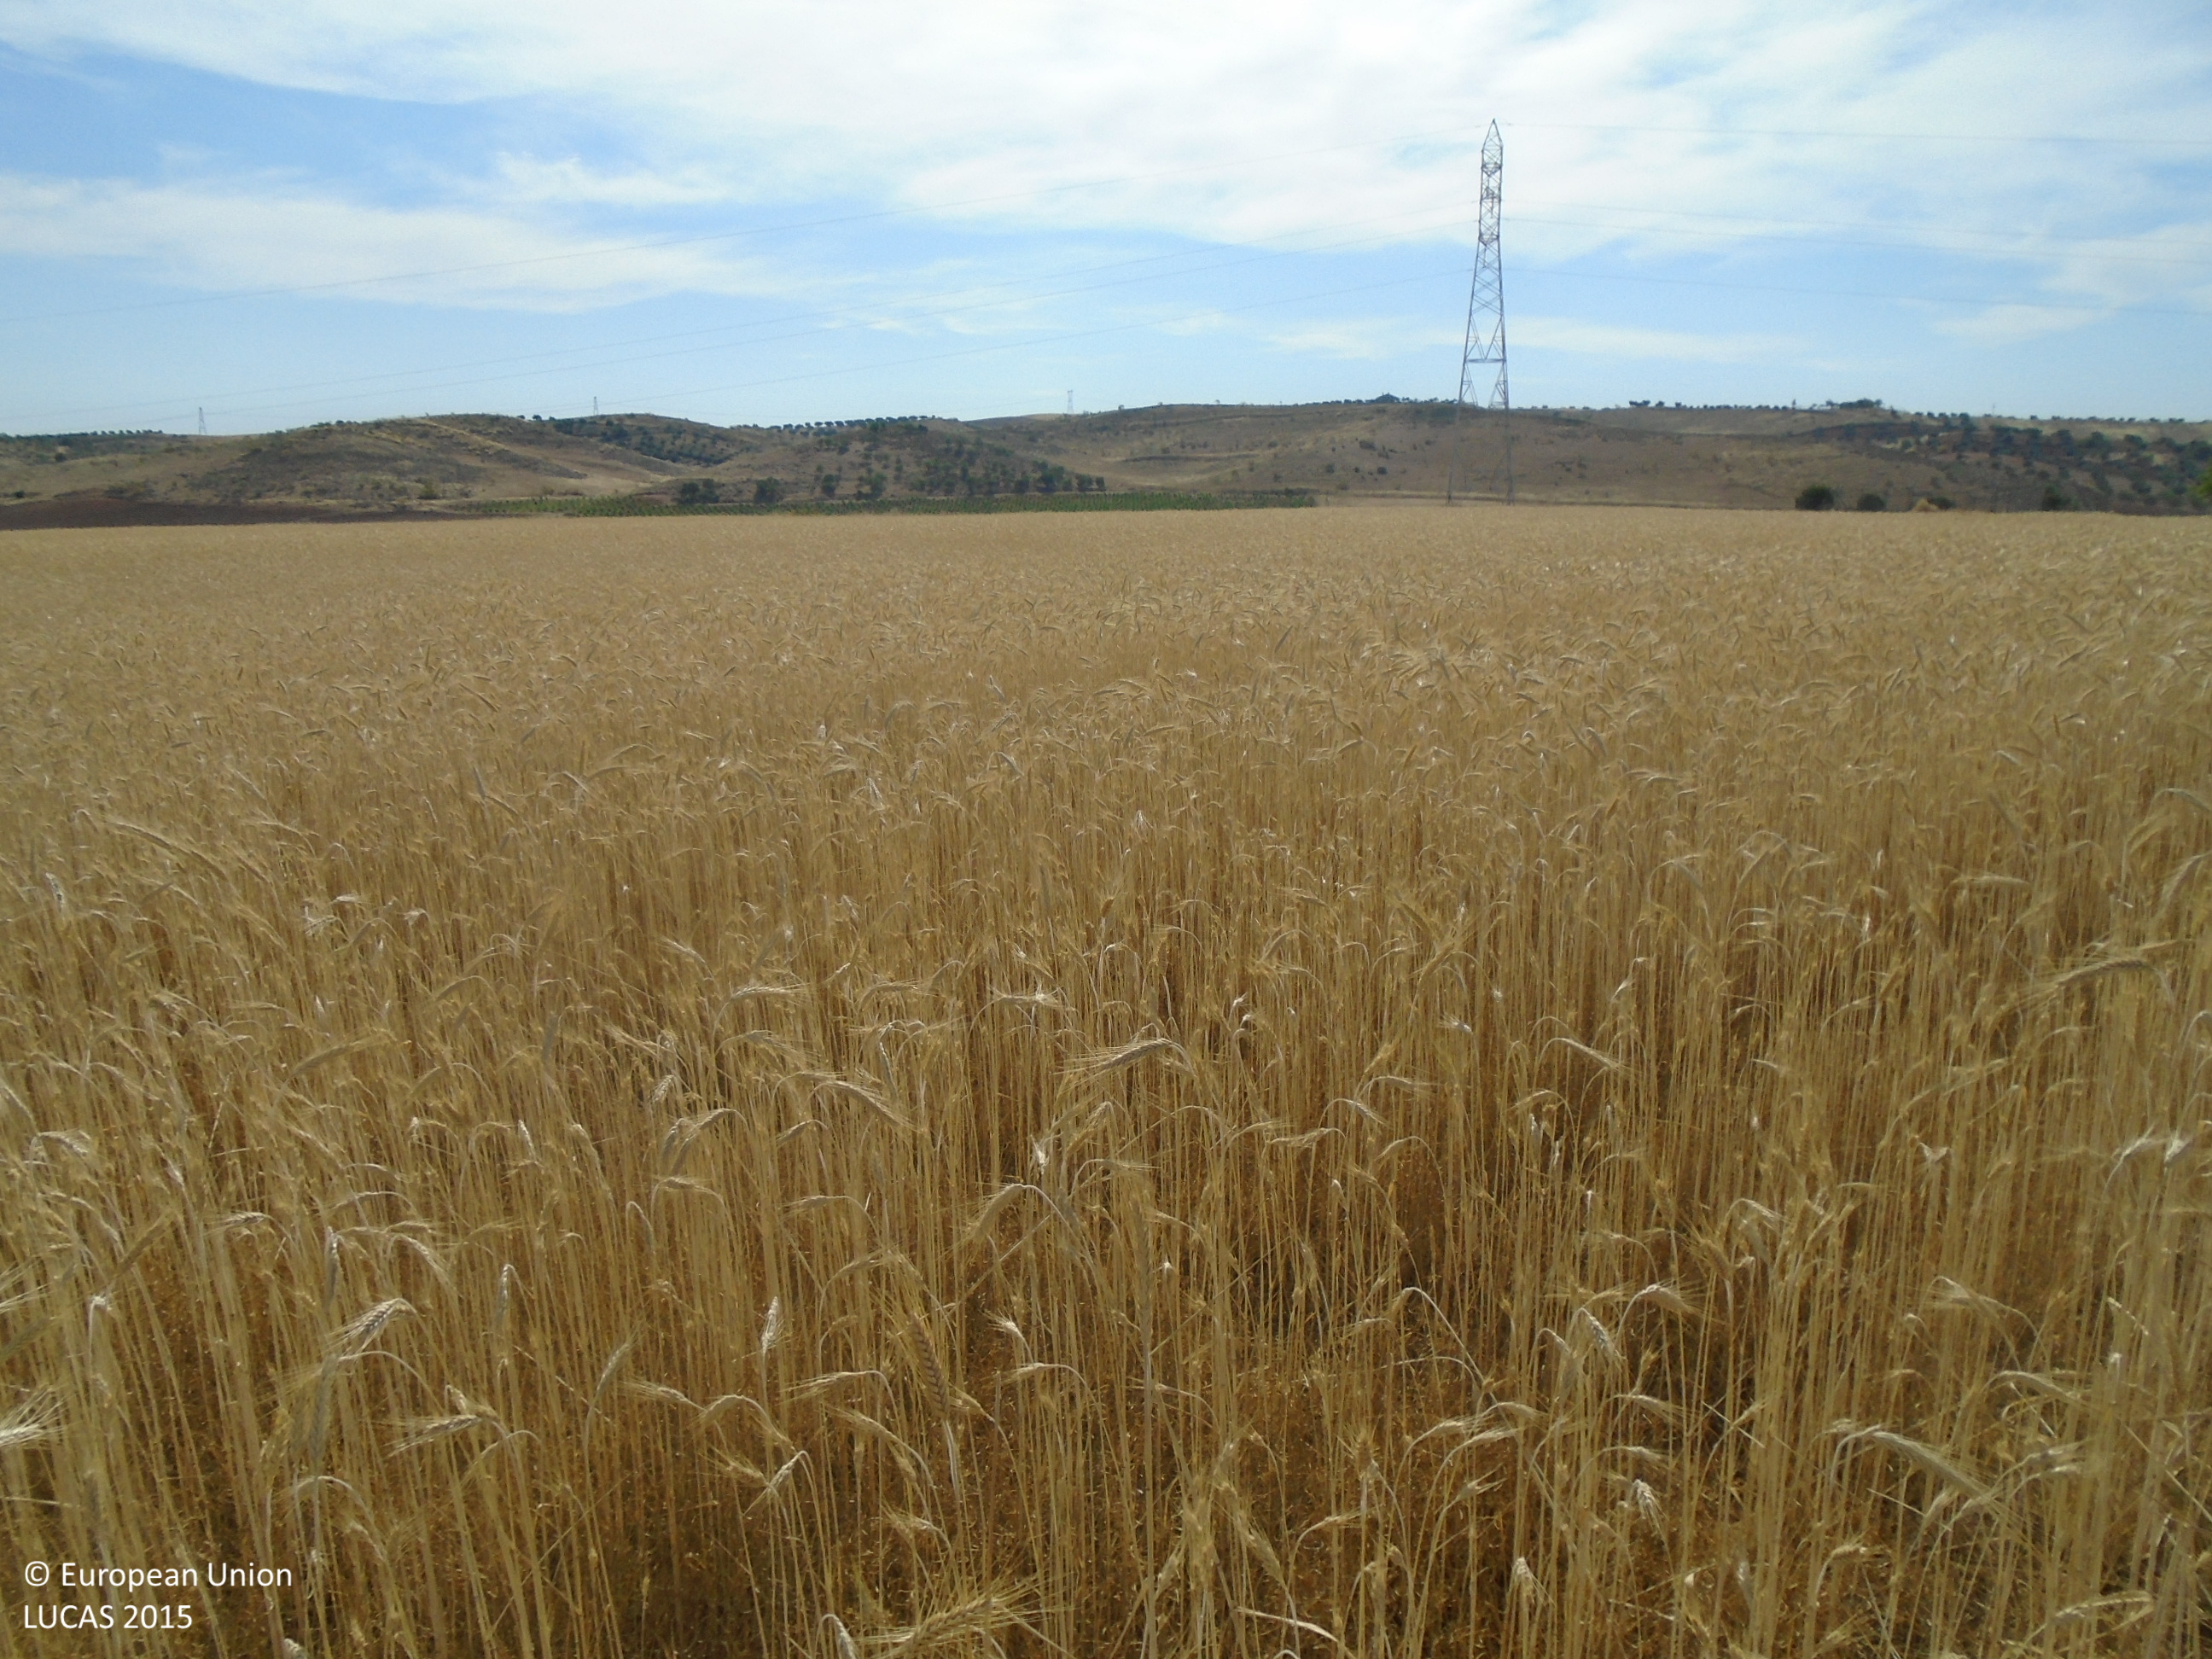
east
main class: Cropland
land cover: Triticale
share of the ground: > 75 %
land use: Agriculture (excluding fallow land and kitchen gardens)
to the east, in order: Triticale; Electric lines; Triticale; Spontaneously vegetated surfaces; Tracks; Grass margins; Triticale; Grass margins; Abandoned hedges; Rivers and streams
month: June
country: ES
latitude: 39.8389
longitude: -3.7851
